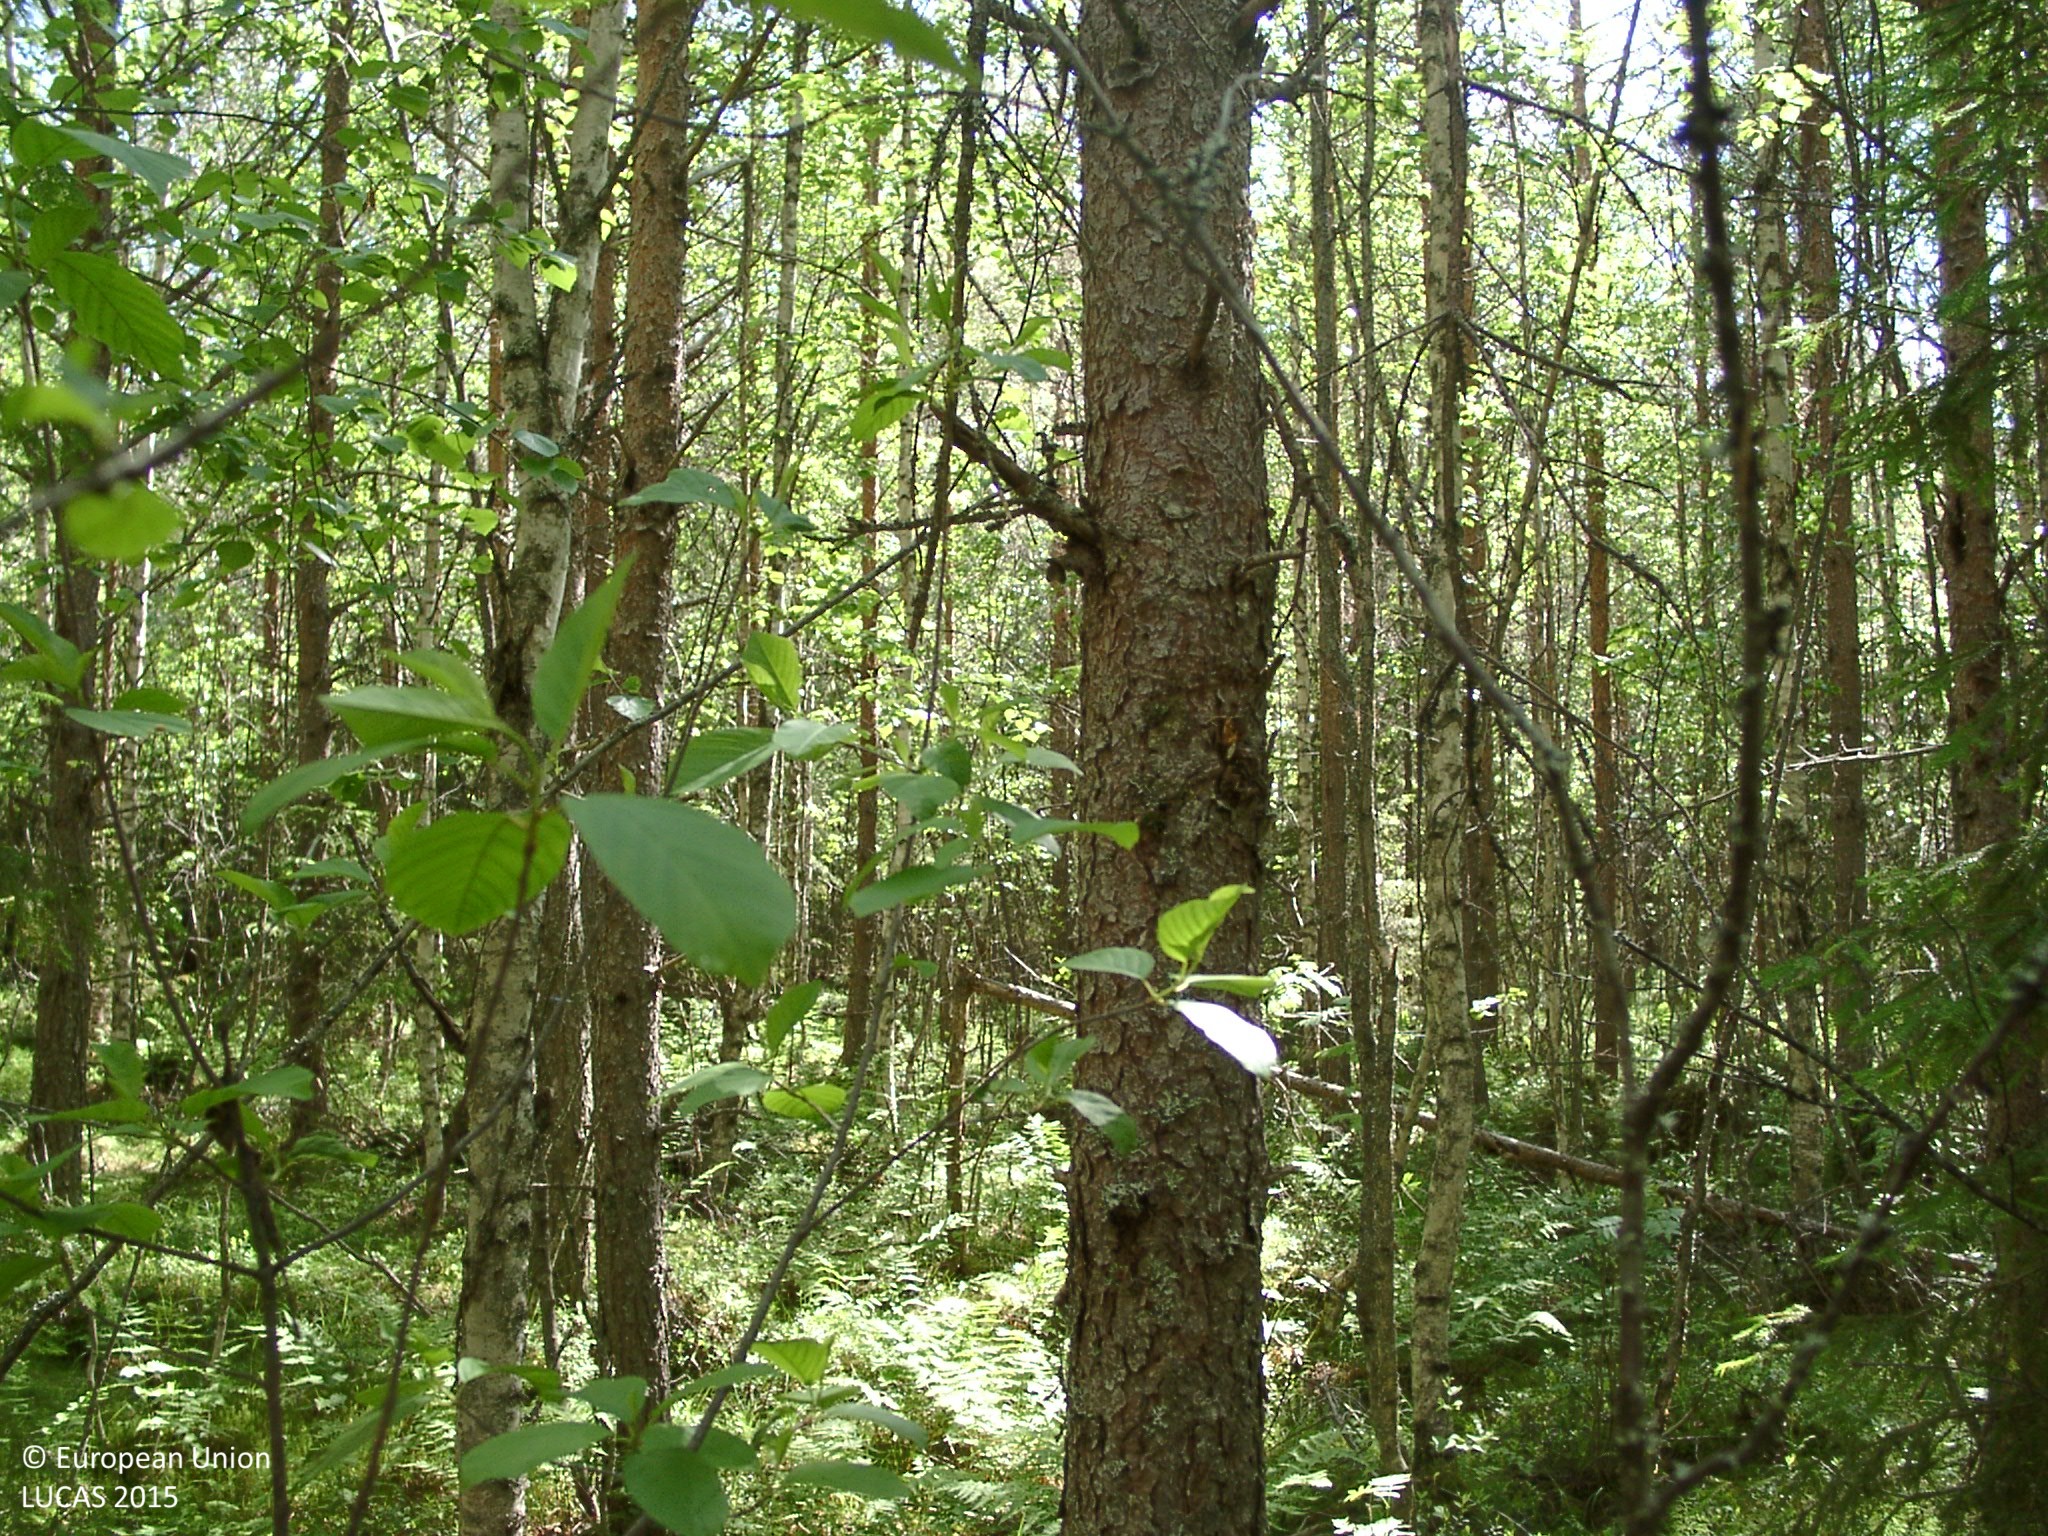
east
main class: Woodland
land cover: Pine dominated mixed woodland
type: boreal forest
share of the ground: 50 - 75 %
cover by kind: coniferous forest trees 45 %, broadleaved forest trees 25 %, shrubs 15 %, herbaceous plants 10 %, lichens and mosses 5 %
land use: Semi-natural and natural areas not in use
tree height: > 5 m
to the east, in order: Pine dominated mixed woodland; Groves; Ditches and canals; Groves; Pine dominated coniferous woodland; Other coniferous woodland; Pine dominated coniferous woodland; Groves; Ditches and canals; Spruce dominated mixed woodland; Ditches and canals; Spruce dominated mixed woodland; Ditches and canals; Other mixed woodland; Ditches and canals; Pine dominated mixed woodland; Groves; Ditches and canals; Groves; Pine dominated mixed woodland; Ditches and canals; Pine dominated mixed woodland; Ditches and canals; Pine dominated mixed woodland
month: June
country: FI
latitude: 62.1481
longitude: 25.0121
